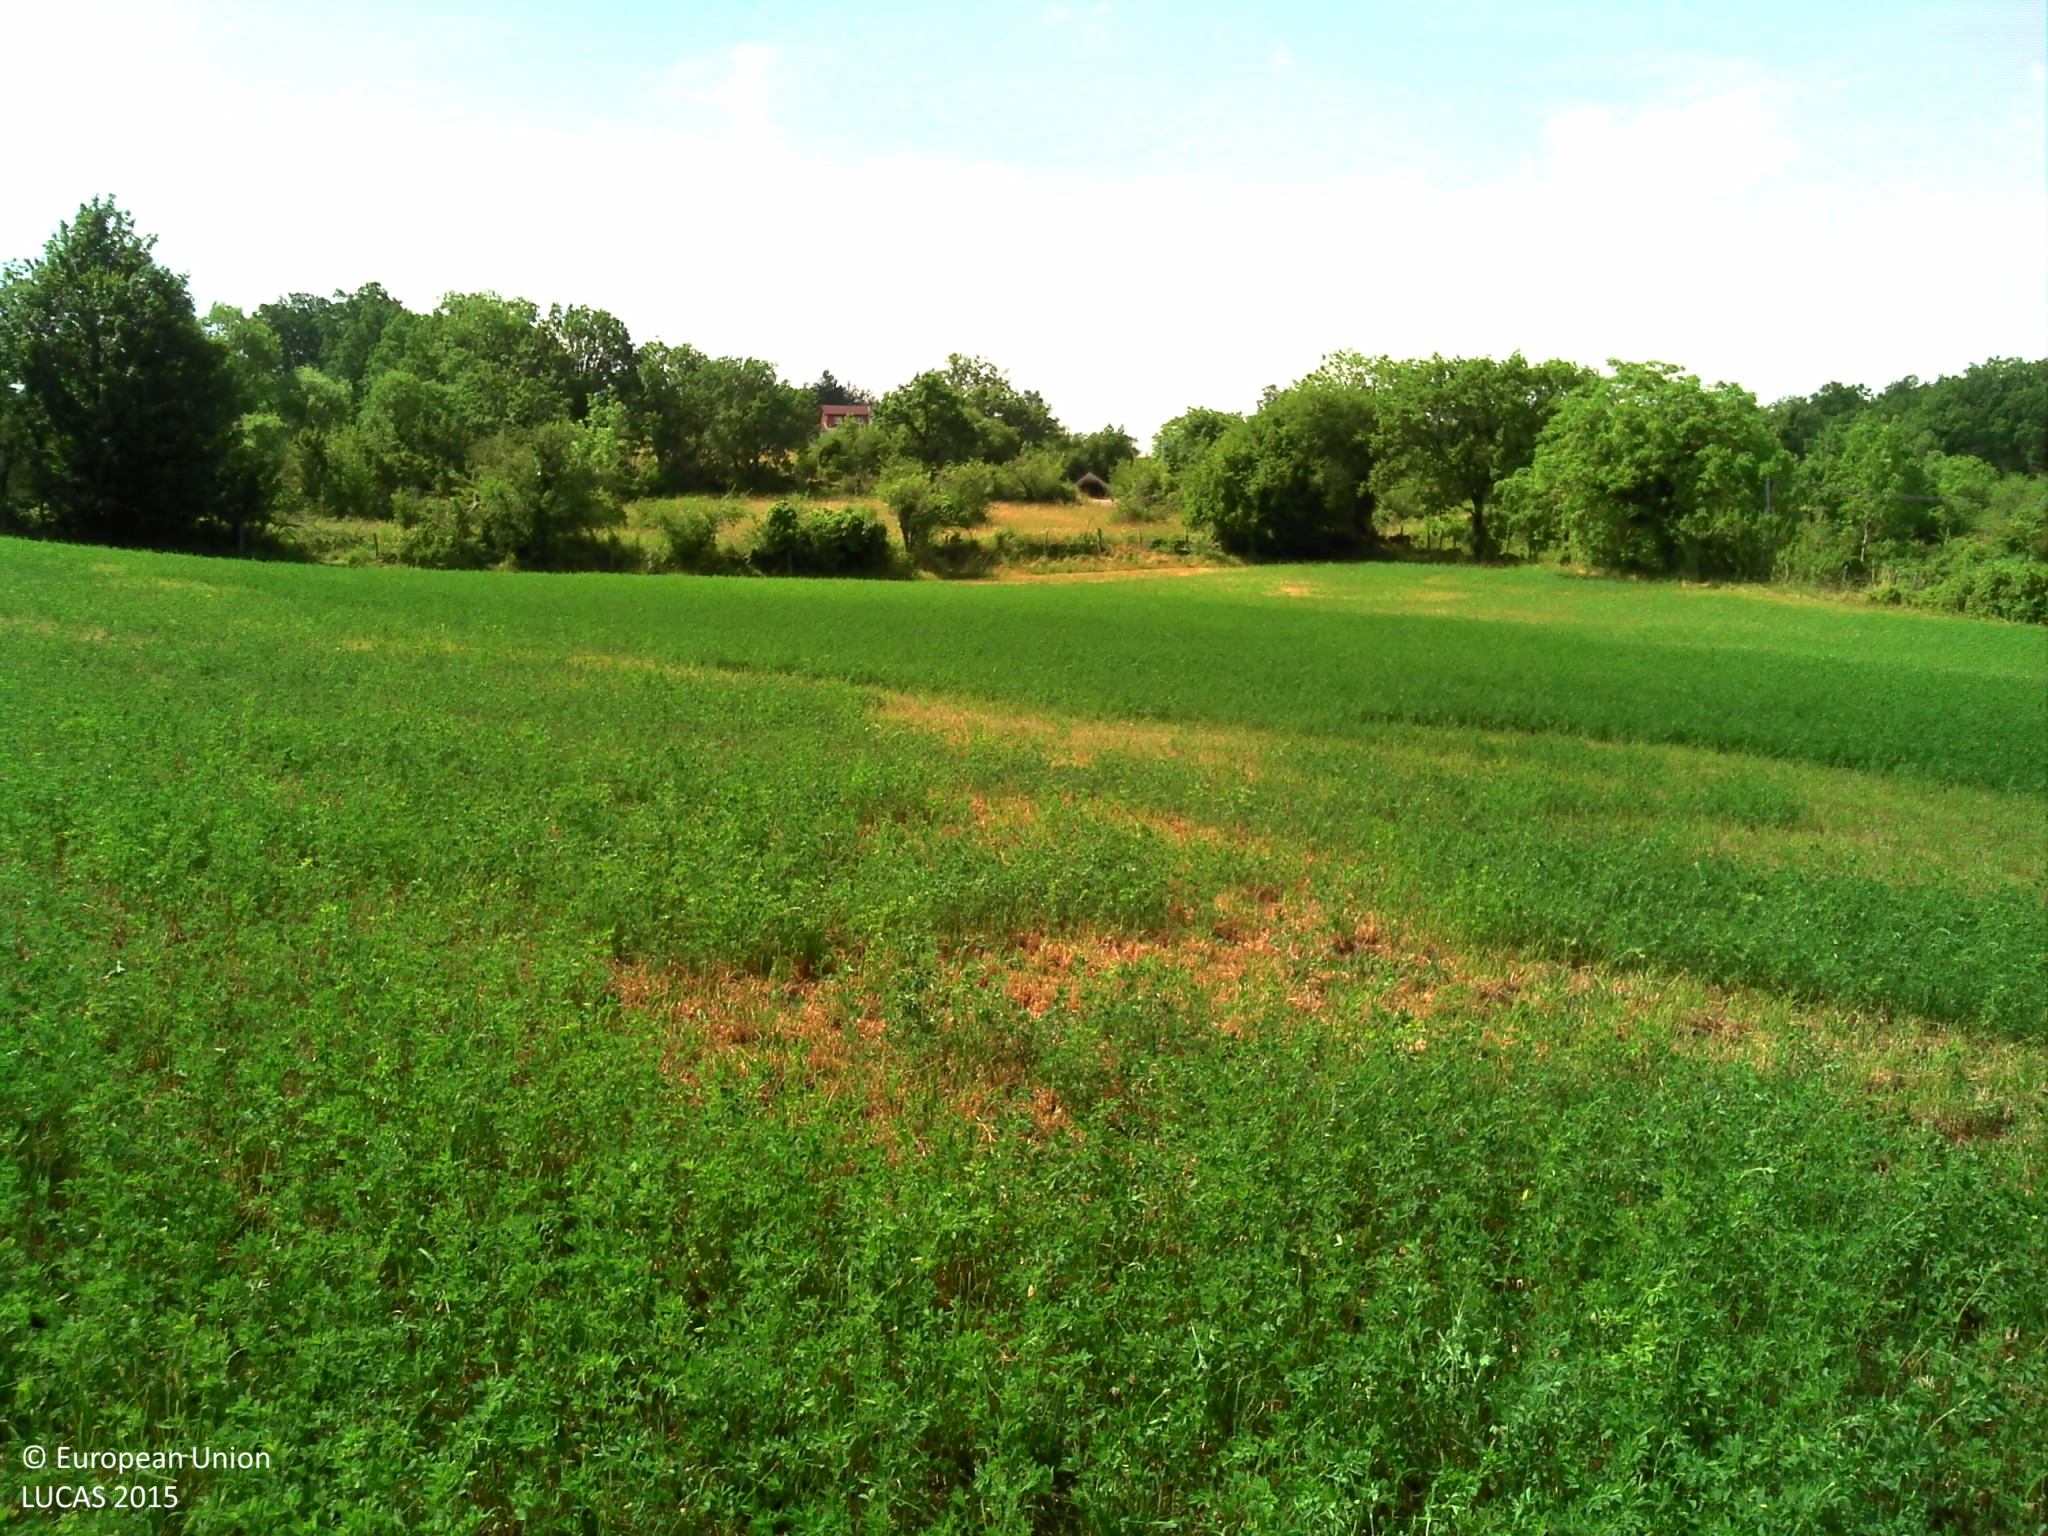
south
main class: Cropland
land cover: Lucerne
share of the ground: > 75 %
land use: Agriculture (excluding fallow land and kitchen gardens)
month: June
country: FR
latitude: 44.4320
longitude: 1.8977
